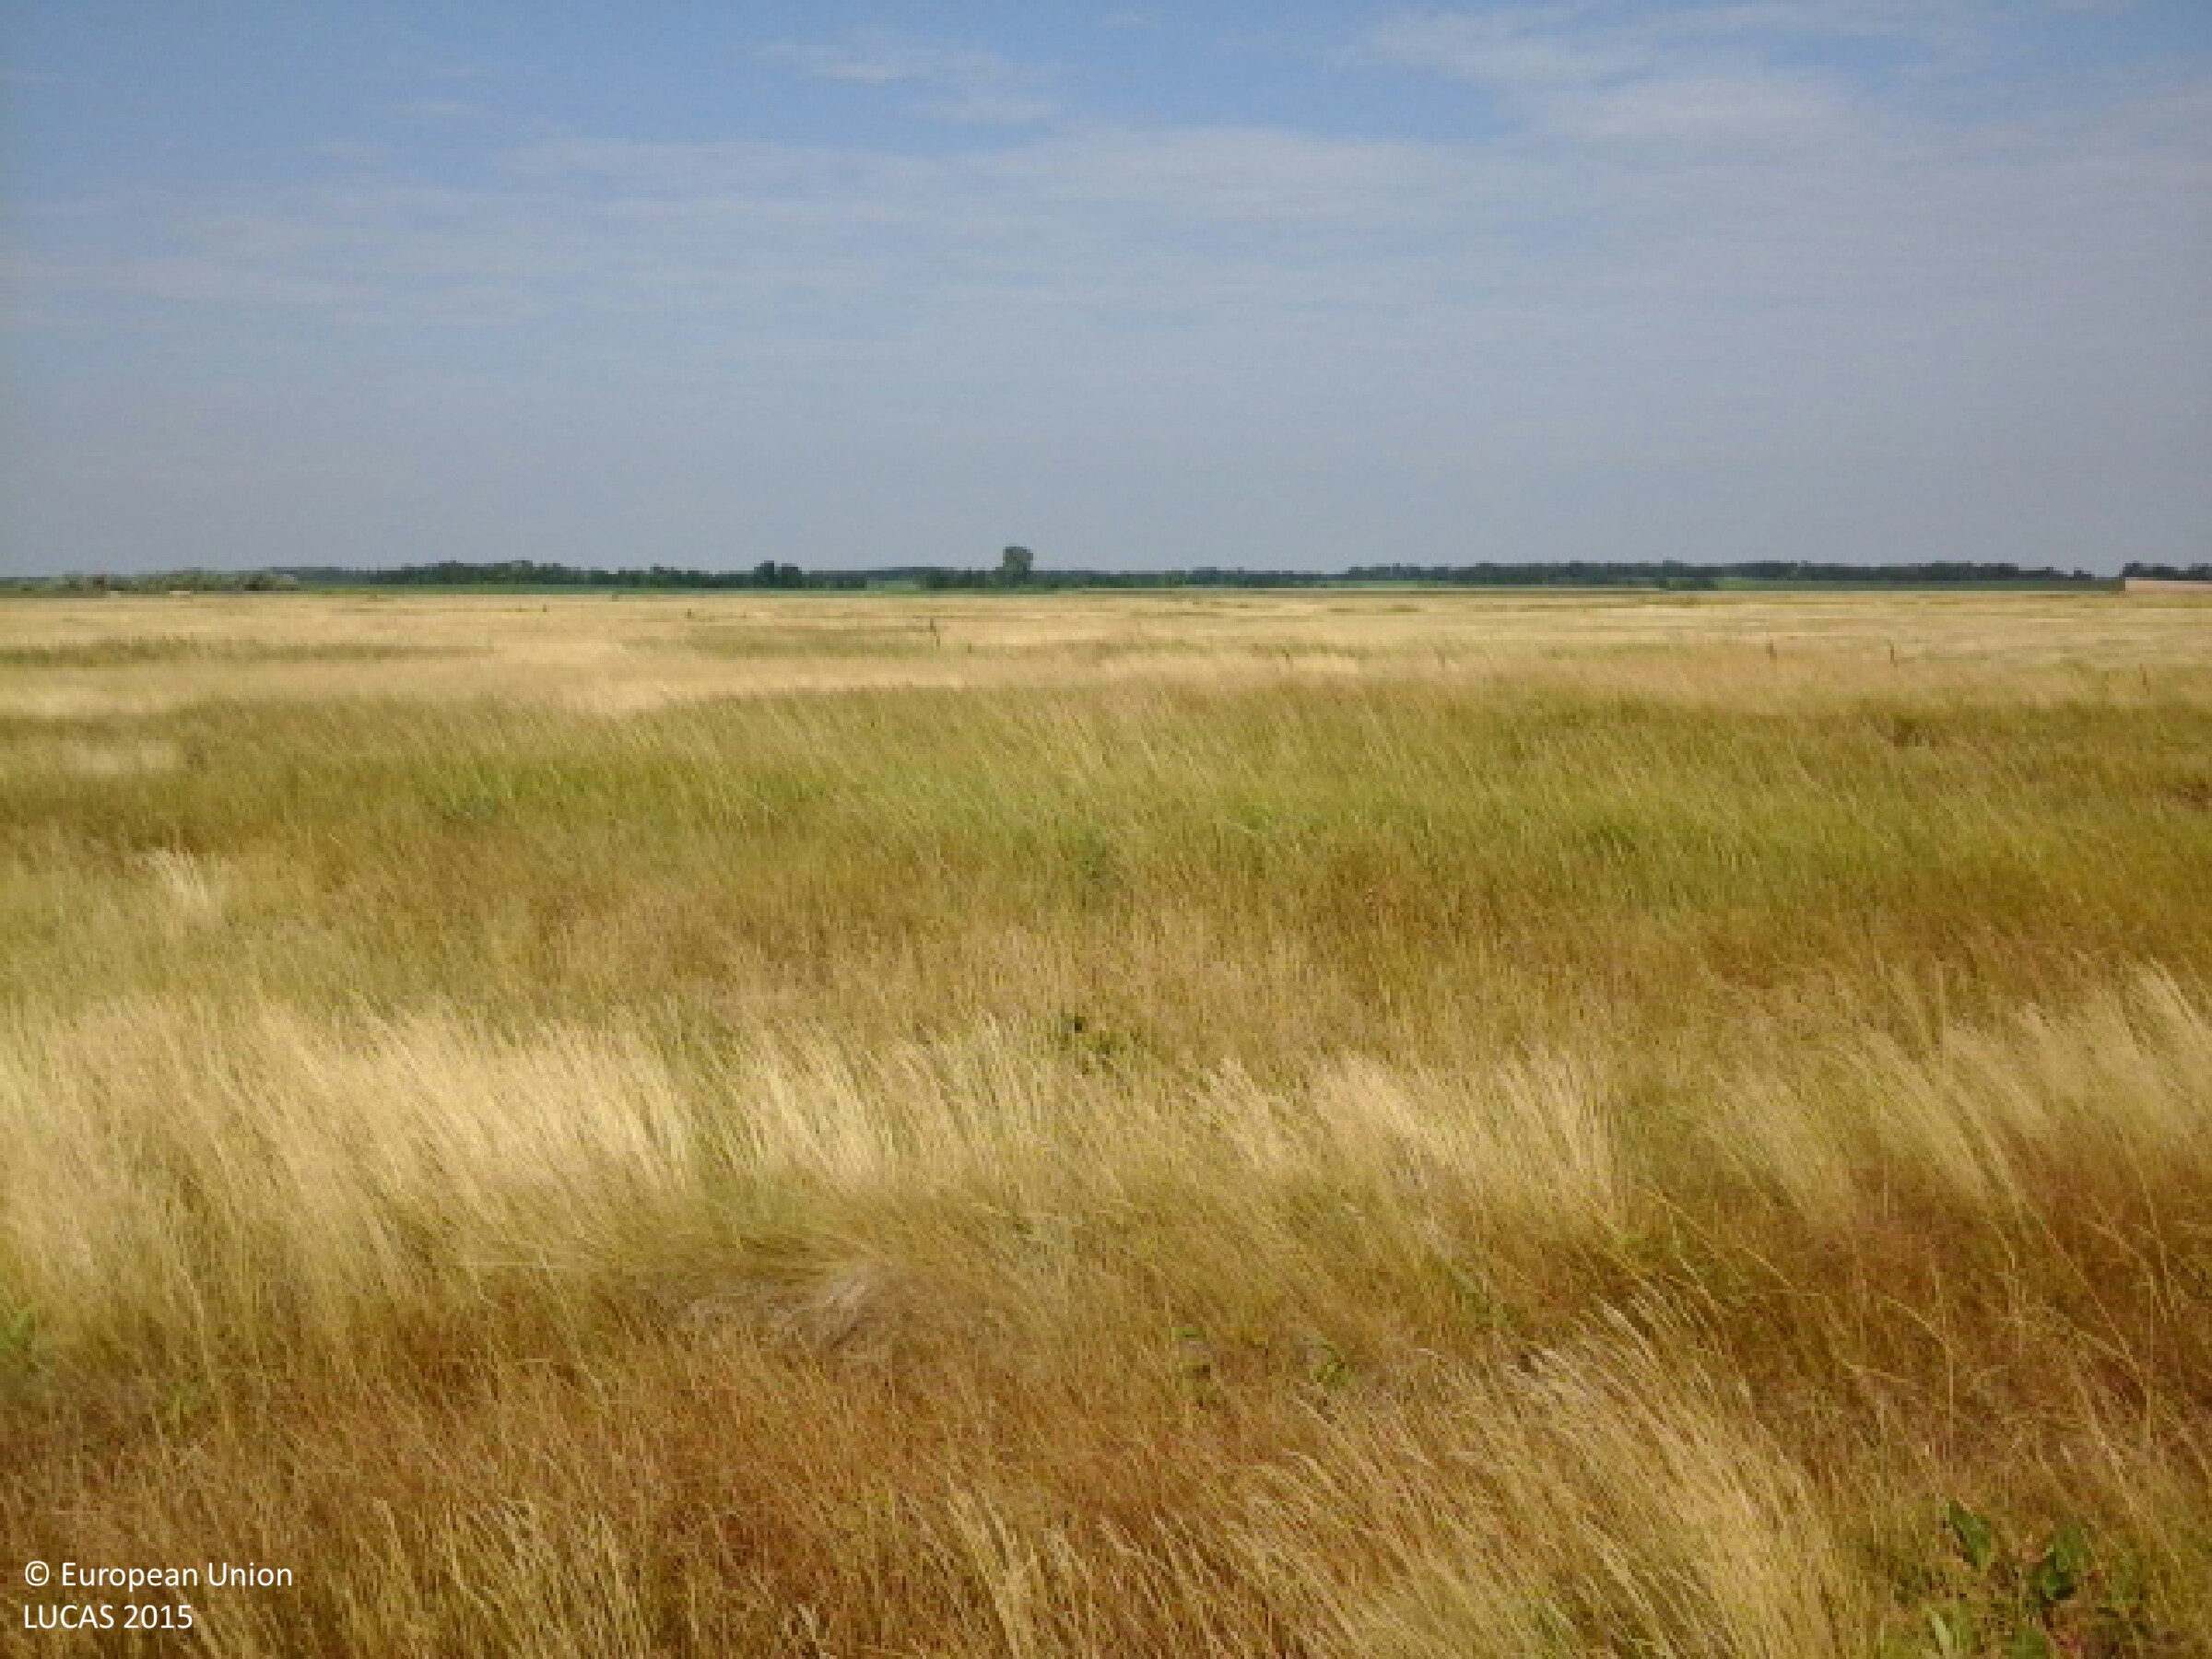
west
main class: Grassland
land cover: Grassland without tree/shrub cover
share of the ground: > 75 %
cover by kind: herbaceous plants 100 %
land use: Semi-natural and natural areas not in use
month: June
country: HU
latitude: 48.0007
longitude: 21.5045
